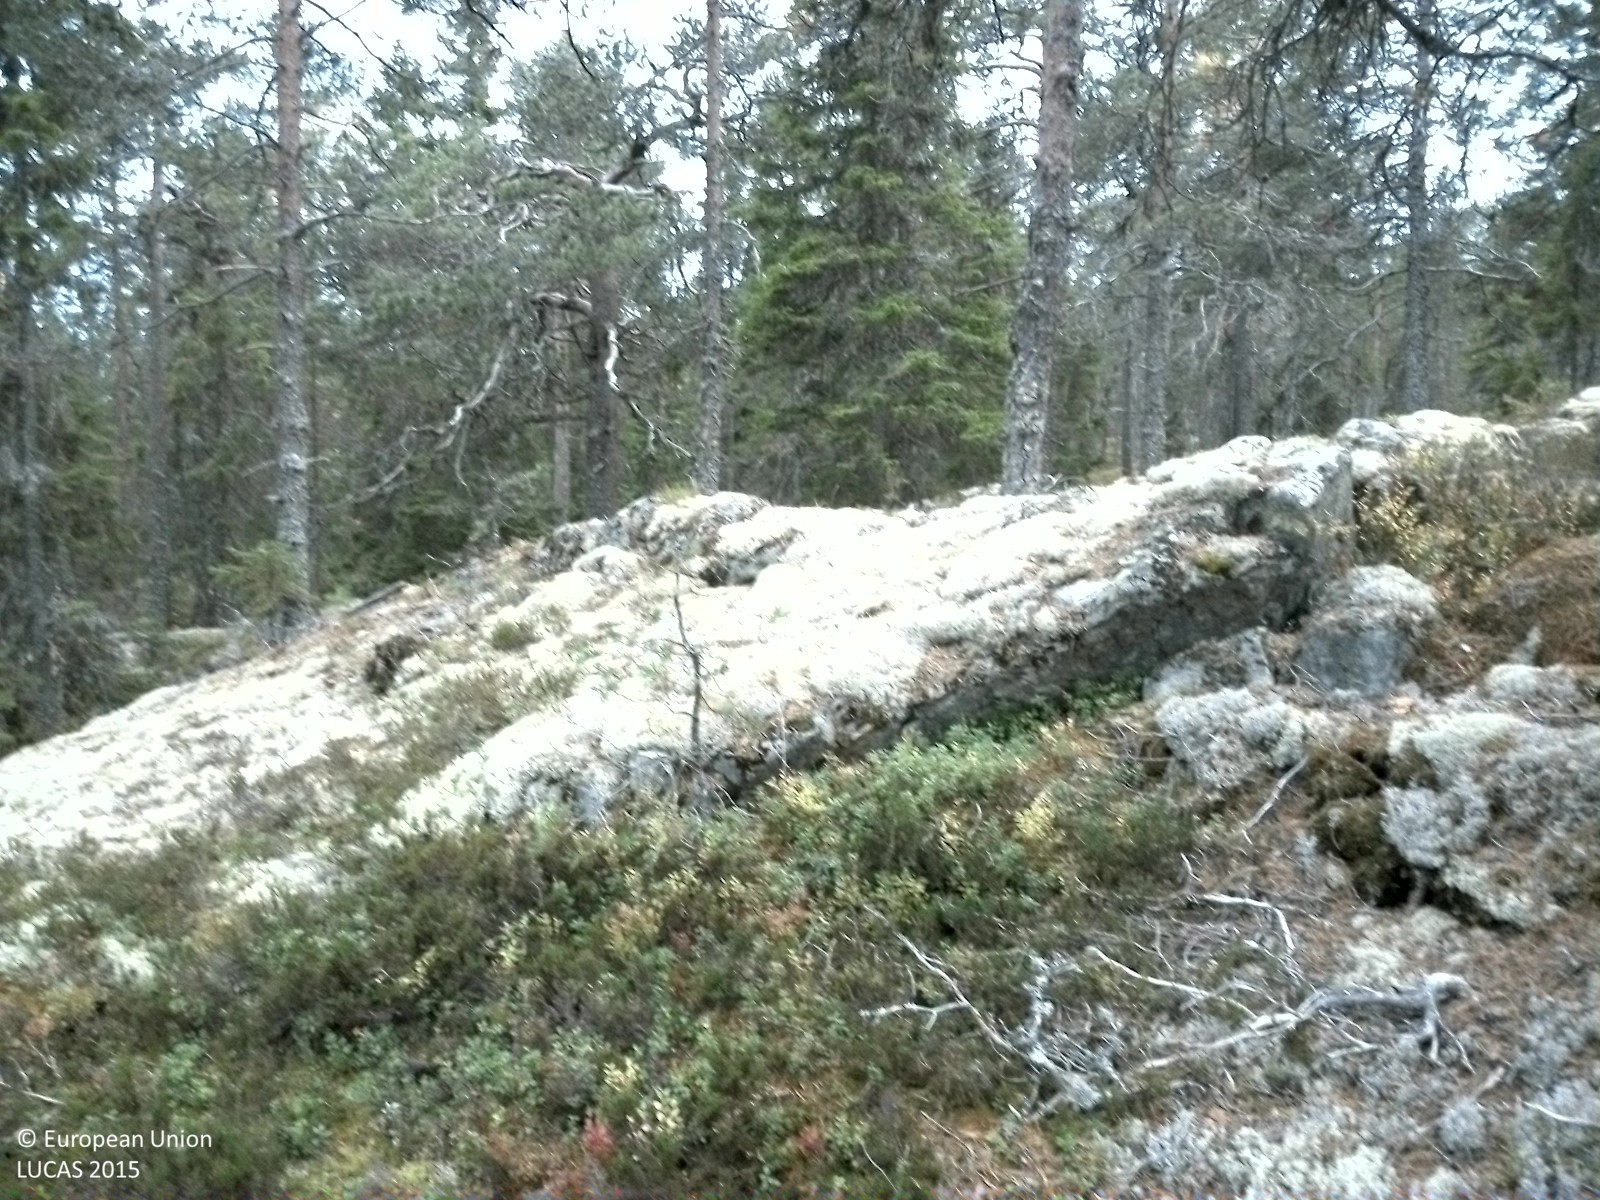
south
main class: Woodland
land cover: Pine dominated coniferous woodland
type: boreal forest
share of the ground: 25 - 50 %
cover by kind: lichens and mosses 40 %, shrubs 30 %, coniferous forest trees 25 %
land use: Forestry
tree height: > 5 m
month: October
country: SE
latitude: 62.5621
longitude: 17.6640
